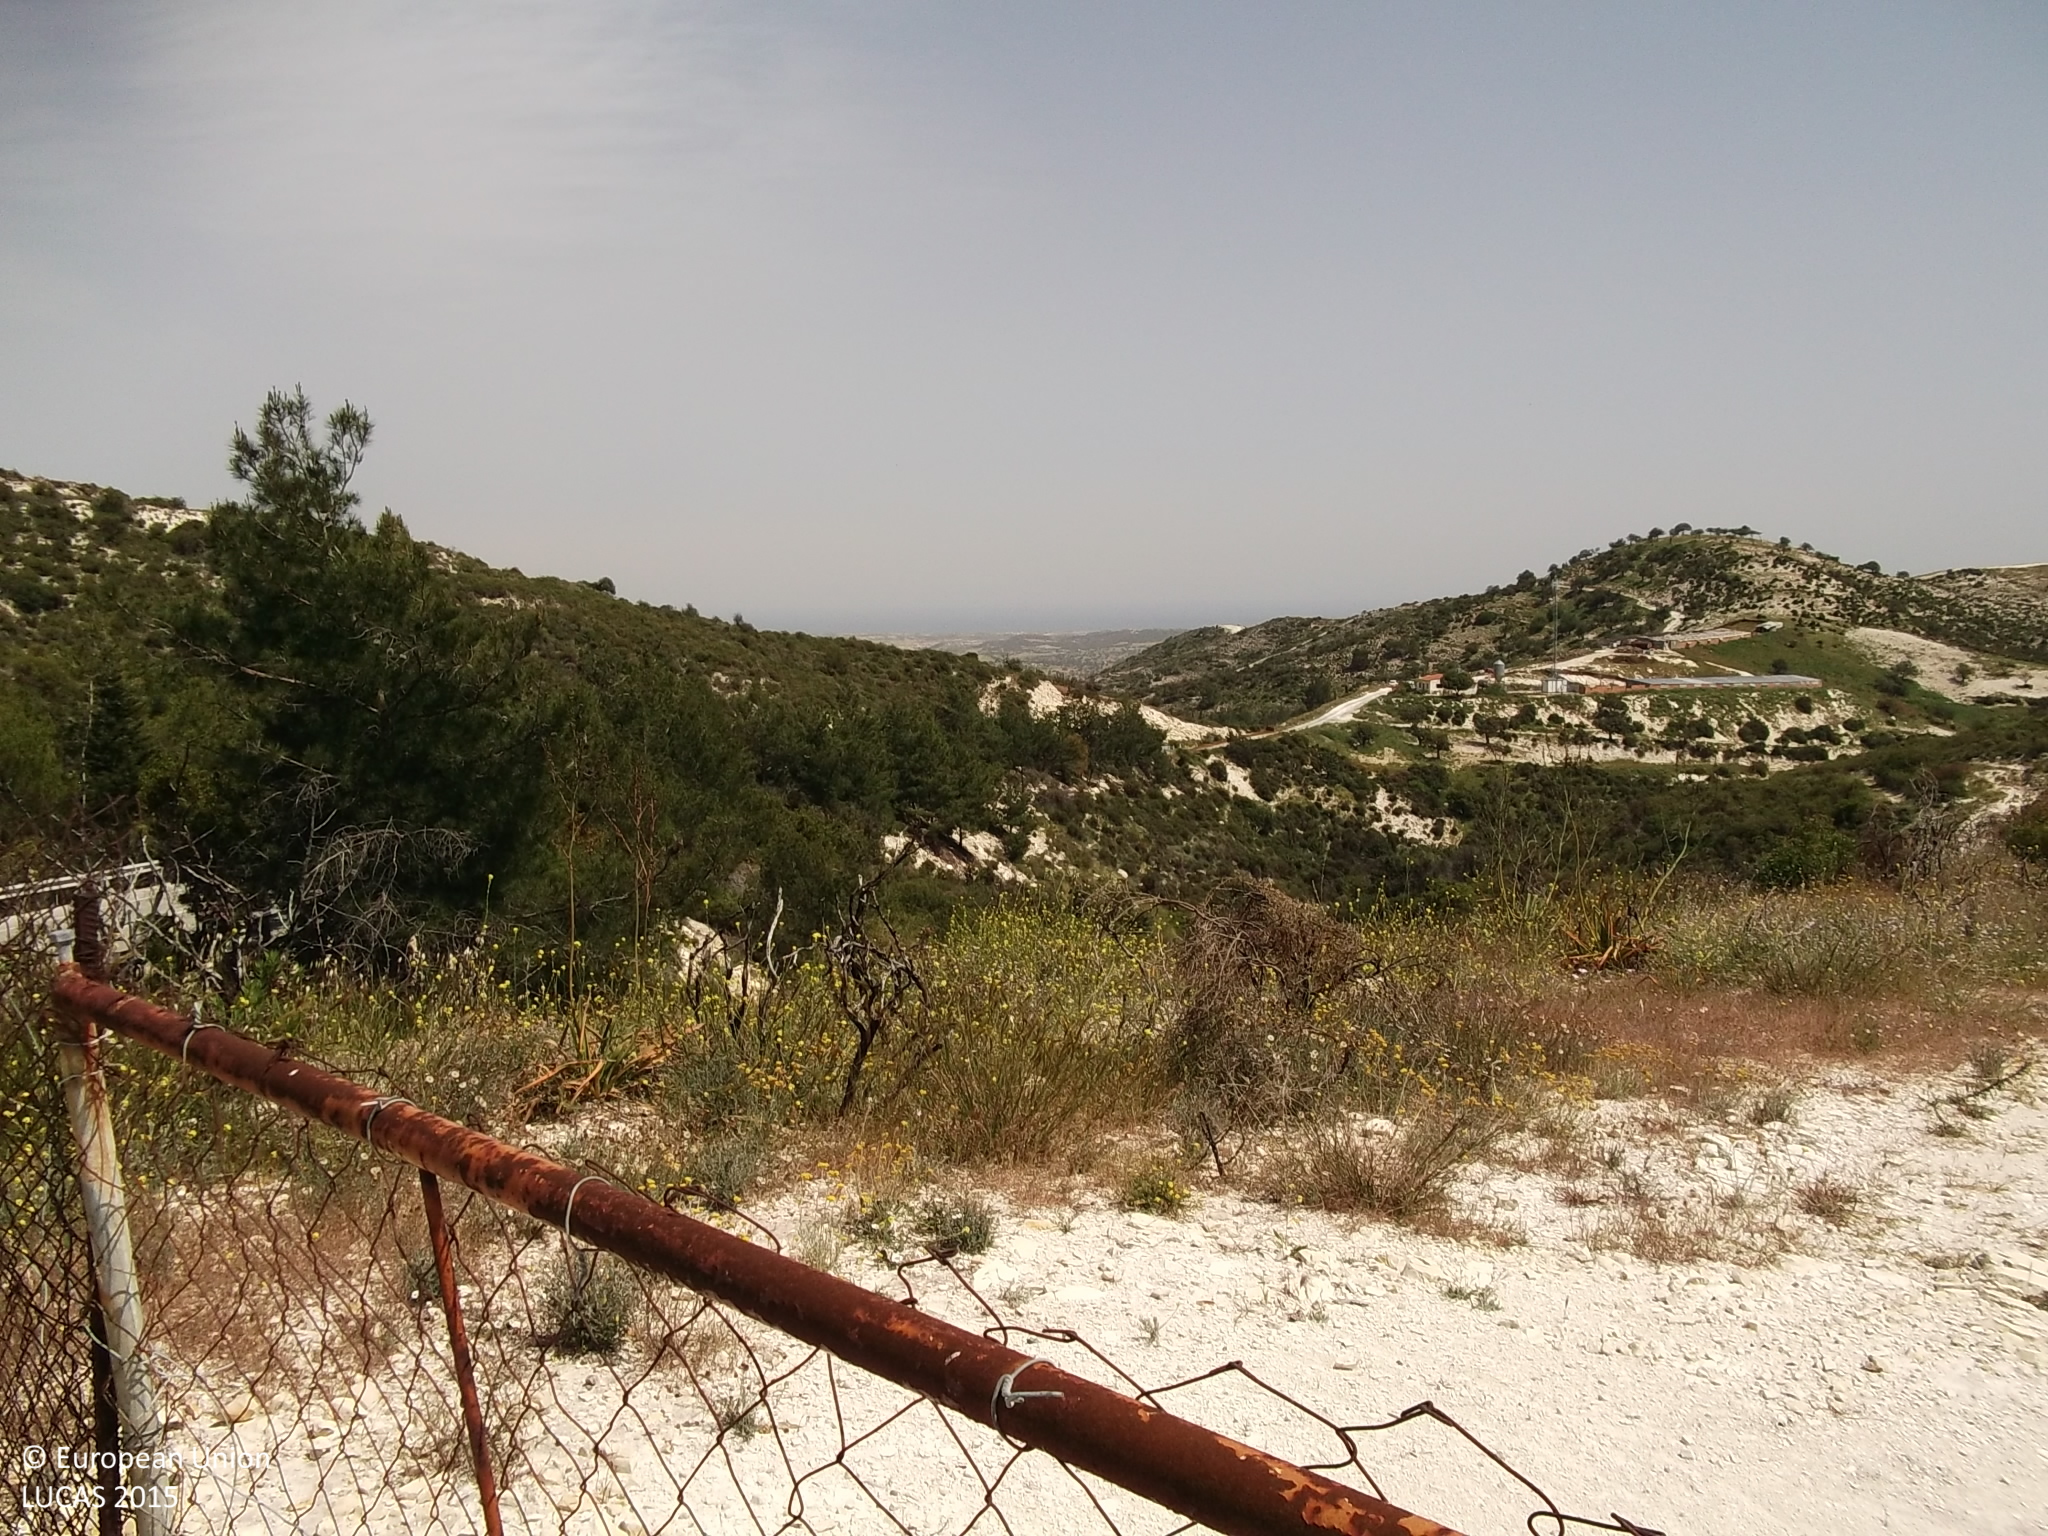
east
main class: Grassland
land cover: Spontaneously vegetated surfaces
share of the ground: 50 - 75 %
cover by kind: herbaceous plants 60 %, unconsolidated bare surface 40 %
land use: Semi-natural and natural areas not in use
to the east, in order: Spontaneously vegetated surfaces; Tracks; Shrubland without tree cover; Tracks; Shrubland without tree cover; Pine dominated mixed woodland; Shrubland without tree cover; Lines of trees; Paved roads, cycling and walking lanes
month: April
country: CY
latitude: 34.8398
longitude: 33.3320
